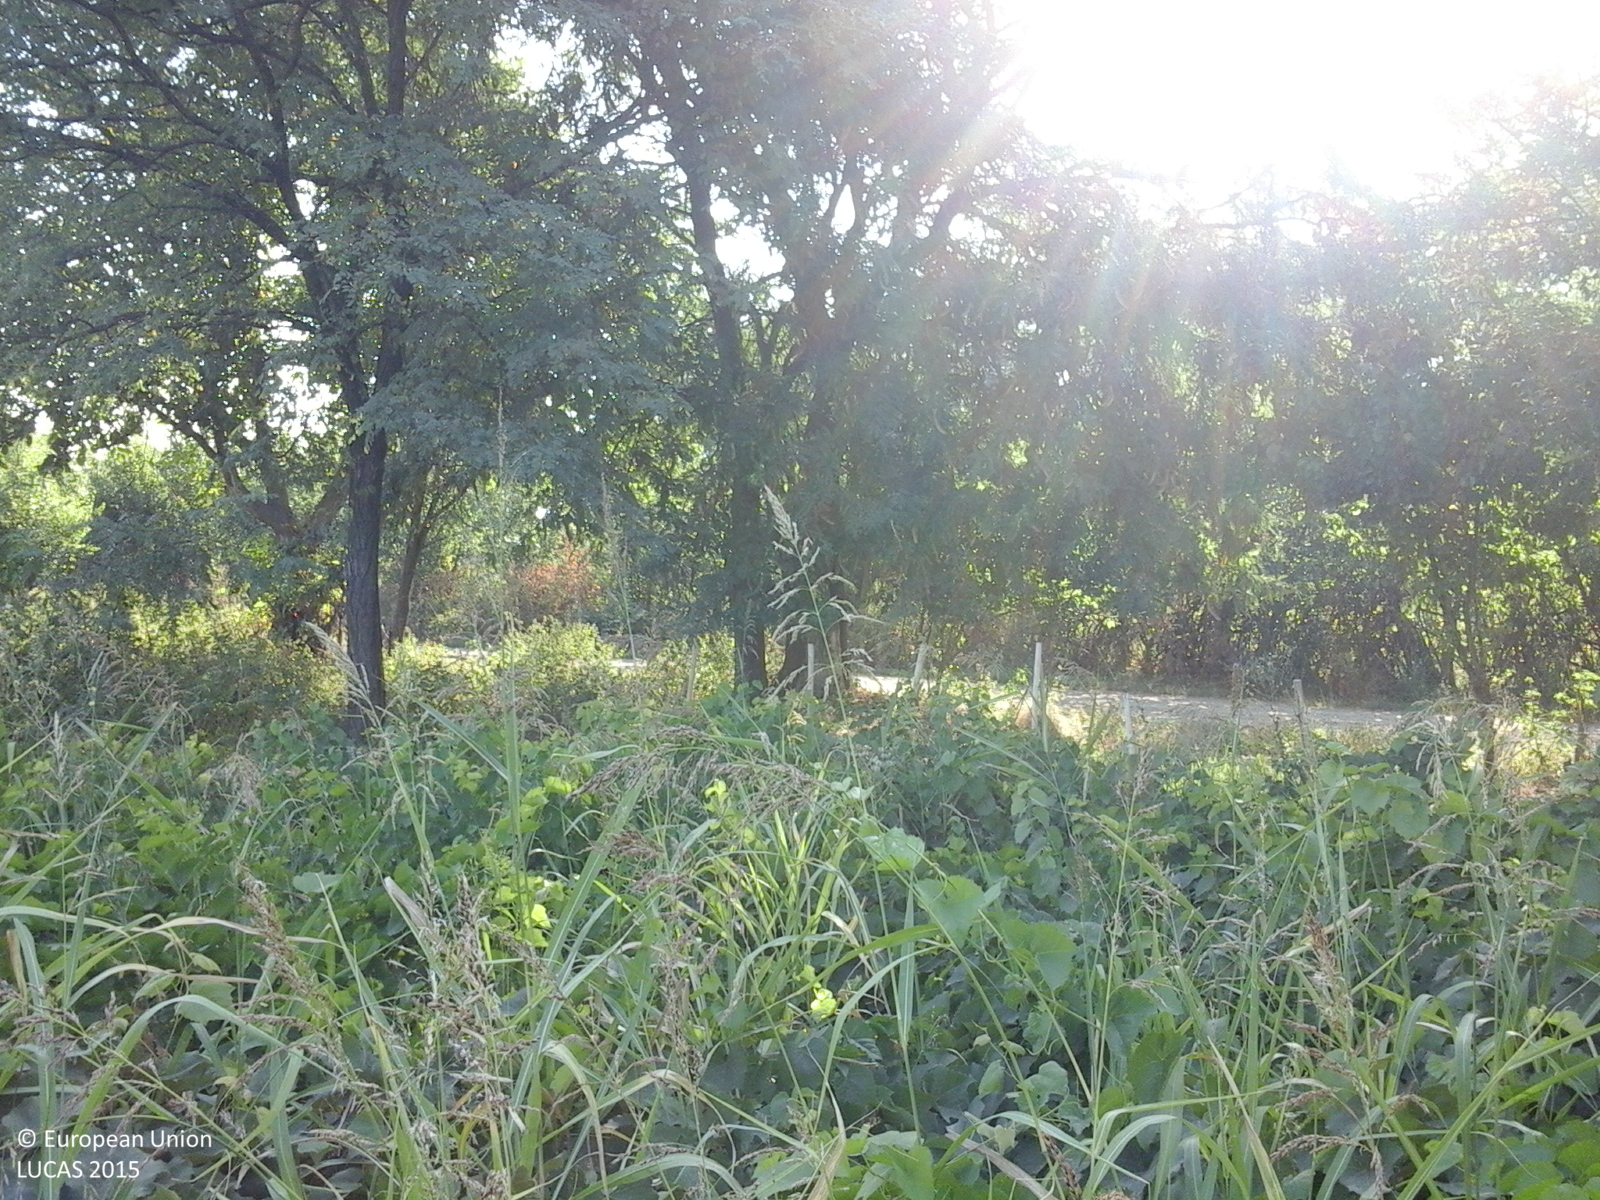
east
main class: Cropland
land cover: Vineyards
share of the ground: 50 - 75 %
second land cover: Grassland without tree/shrub cover
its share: > 75 %
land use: Agriculture (excluding fallow land and kitchen gardens)
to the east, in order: Vineyards; Grassland without tree/shrub cover; Abandoned hedges; Grass margins; Tracks; Grass margins; Fences; Abandoned hedges; Other fresh vegetables; Maize; Abandoned hedges; Arable land (only in case pi); Abandoned hedges; Arable land (only in case pi); Abandoned hedges; Arable land (only in case pi); Abandoned hedges; Arable land (only in case pi); Abandoned hedges; Maize
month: August
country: RO
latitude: 44.0928
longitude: 23.2990
